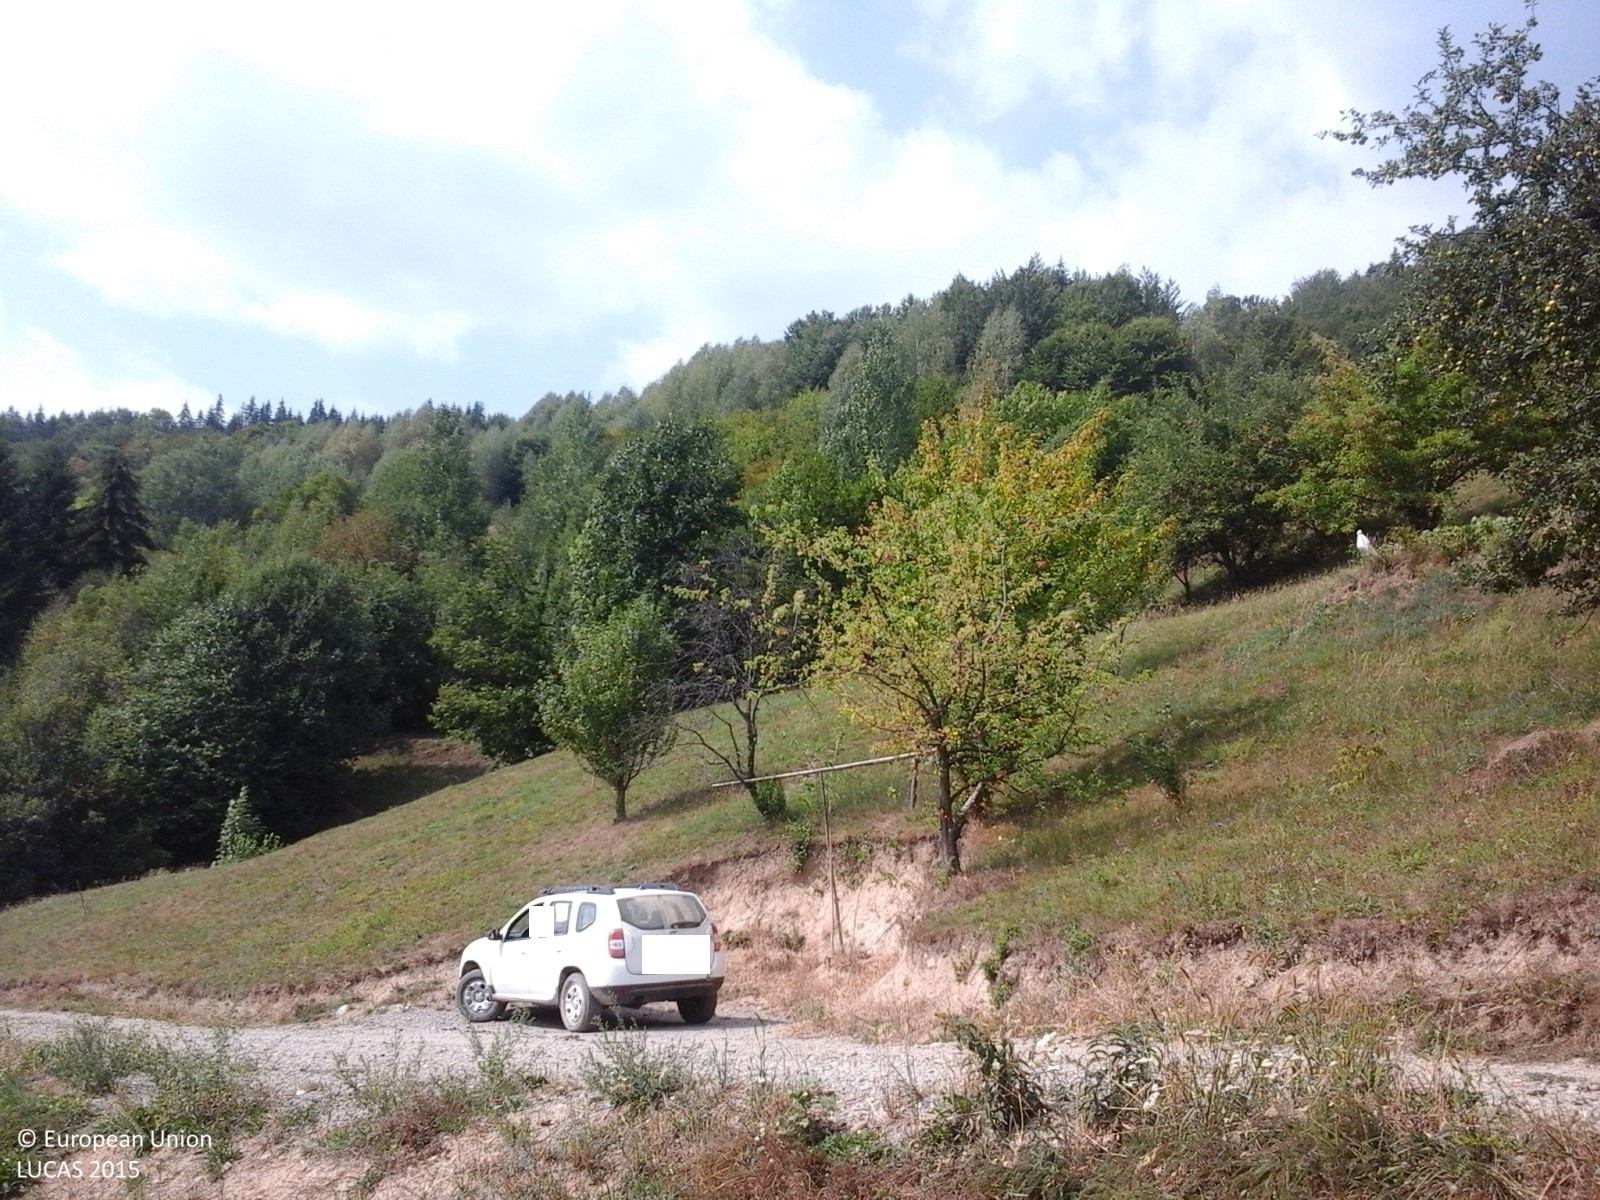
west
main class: Cropland
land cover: Apple fruit
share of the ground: 10 - 25 %
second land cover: Grassland without tree/shrub cover
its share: > 75 %
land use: Agriculture (excluding fallow land and kitchen gardens)
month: September
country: RO
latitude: 47.8521
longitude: 24.4344
